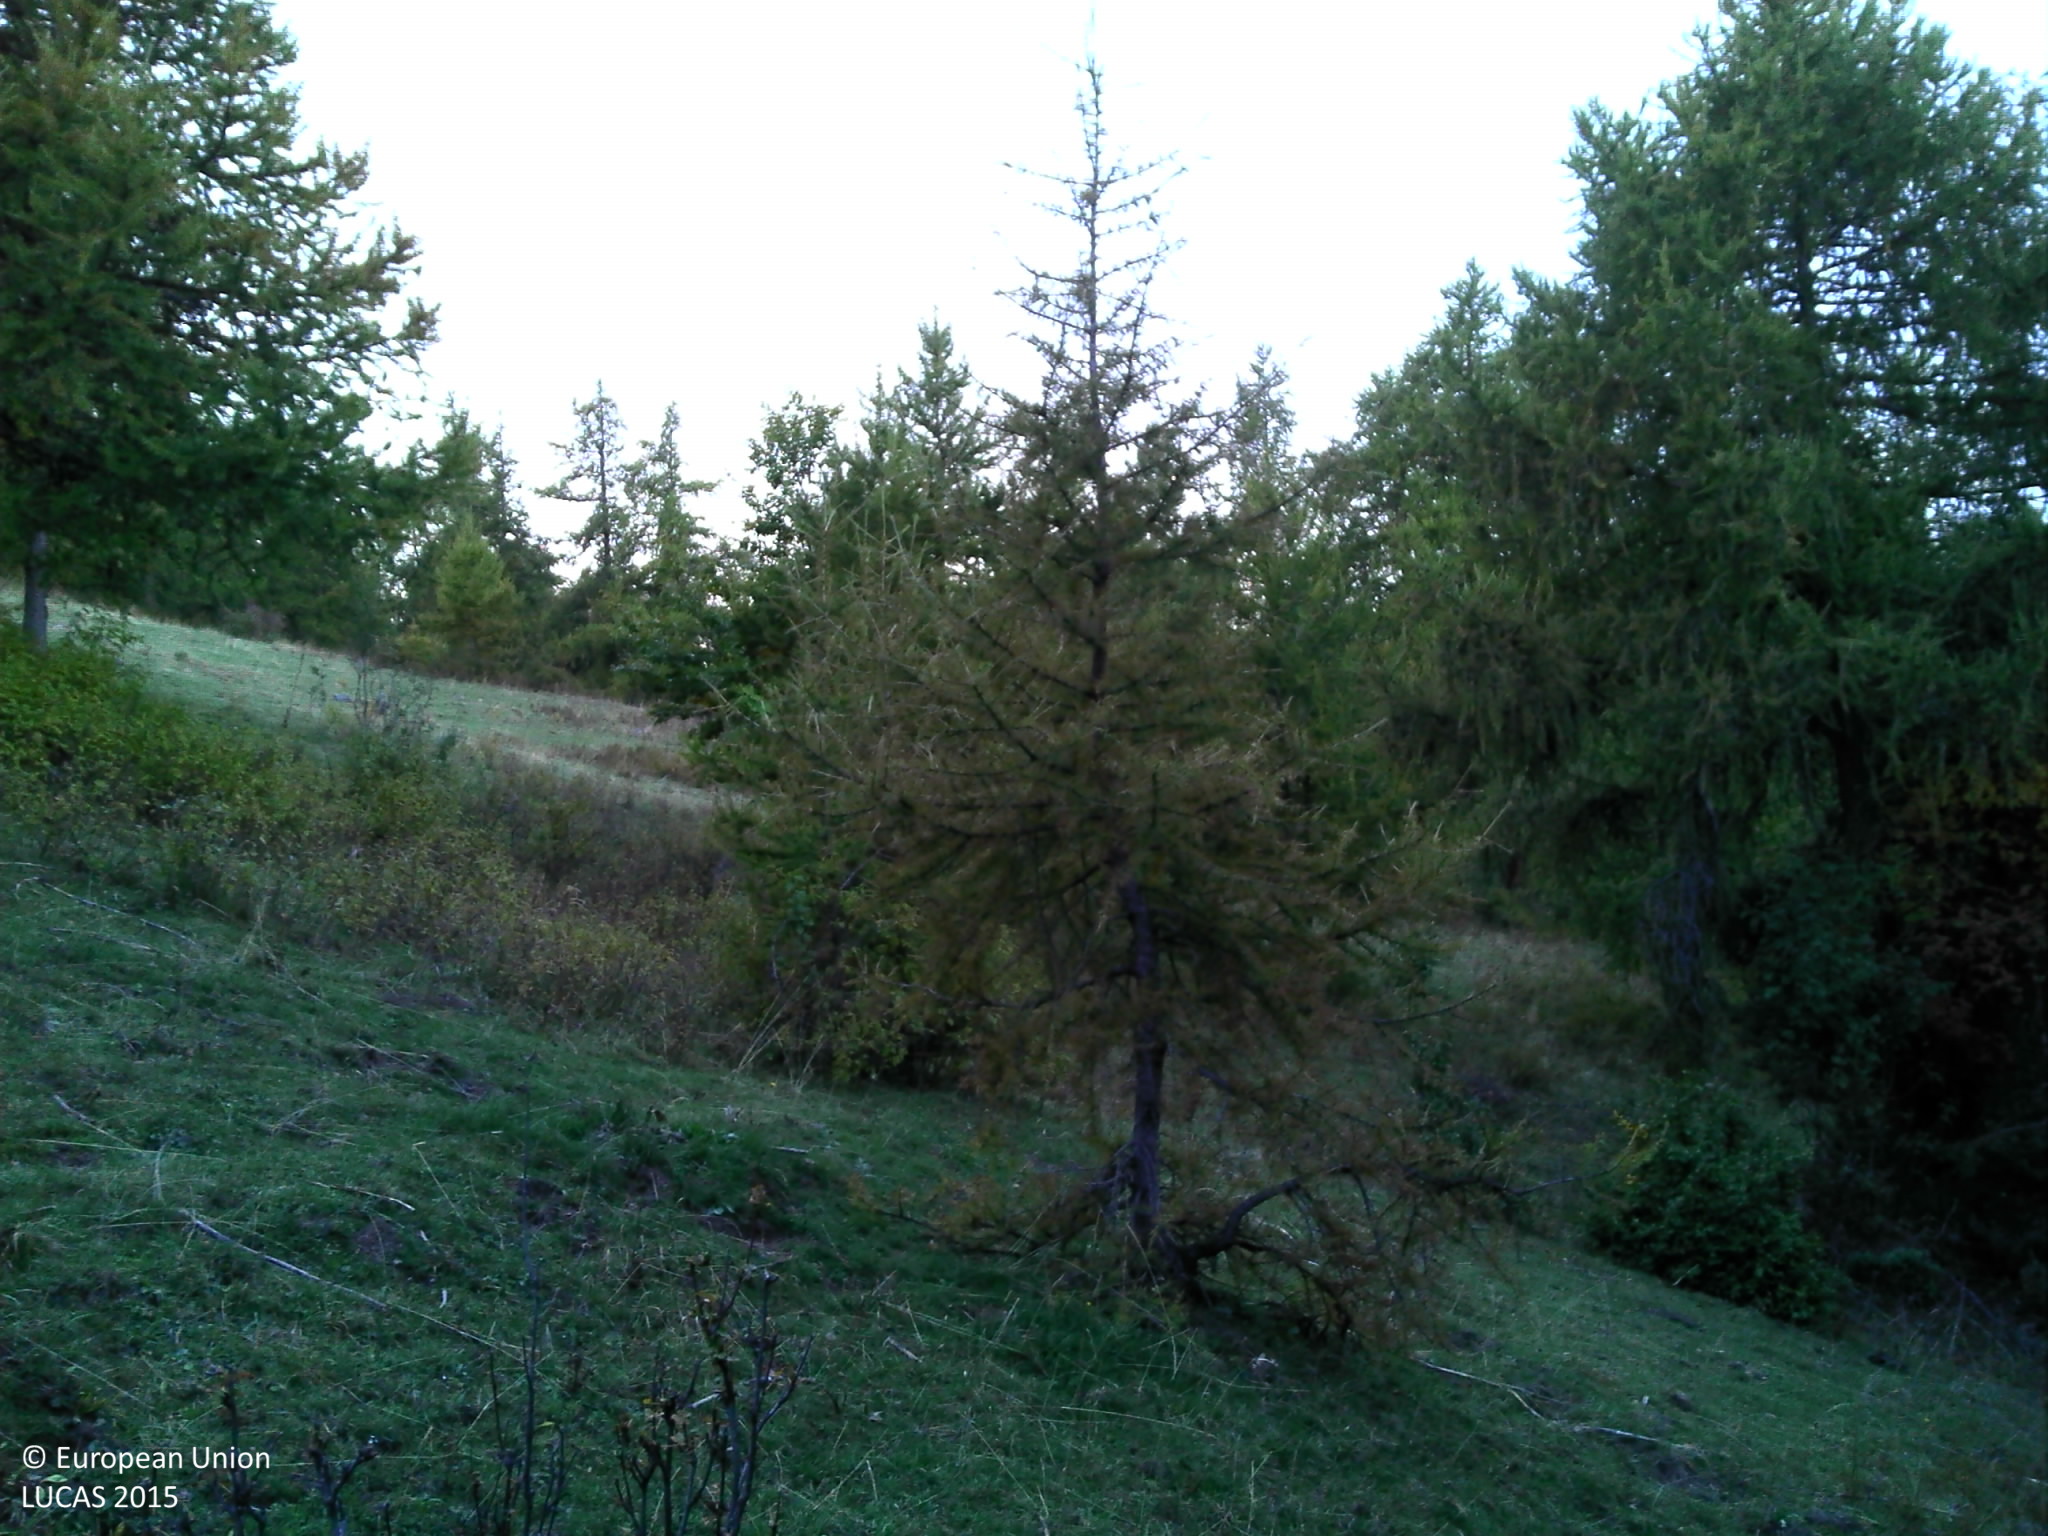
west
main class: Grassland
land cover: Grassland with sparse tree/shrub cover
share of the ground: > 75 %
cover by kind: herbaceous plants 85 %, shrubs 10 %, coniferous forest trees 5 %
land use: Agriculture (excluding fallow land and kitchen gardens)
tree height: > 5 m
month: September
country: FR
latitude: 44.4984
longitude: 6.2211
